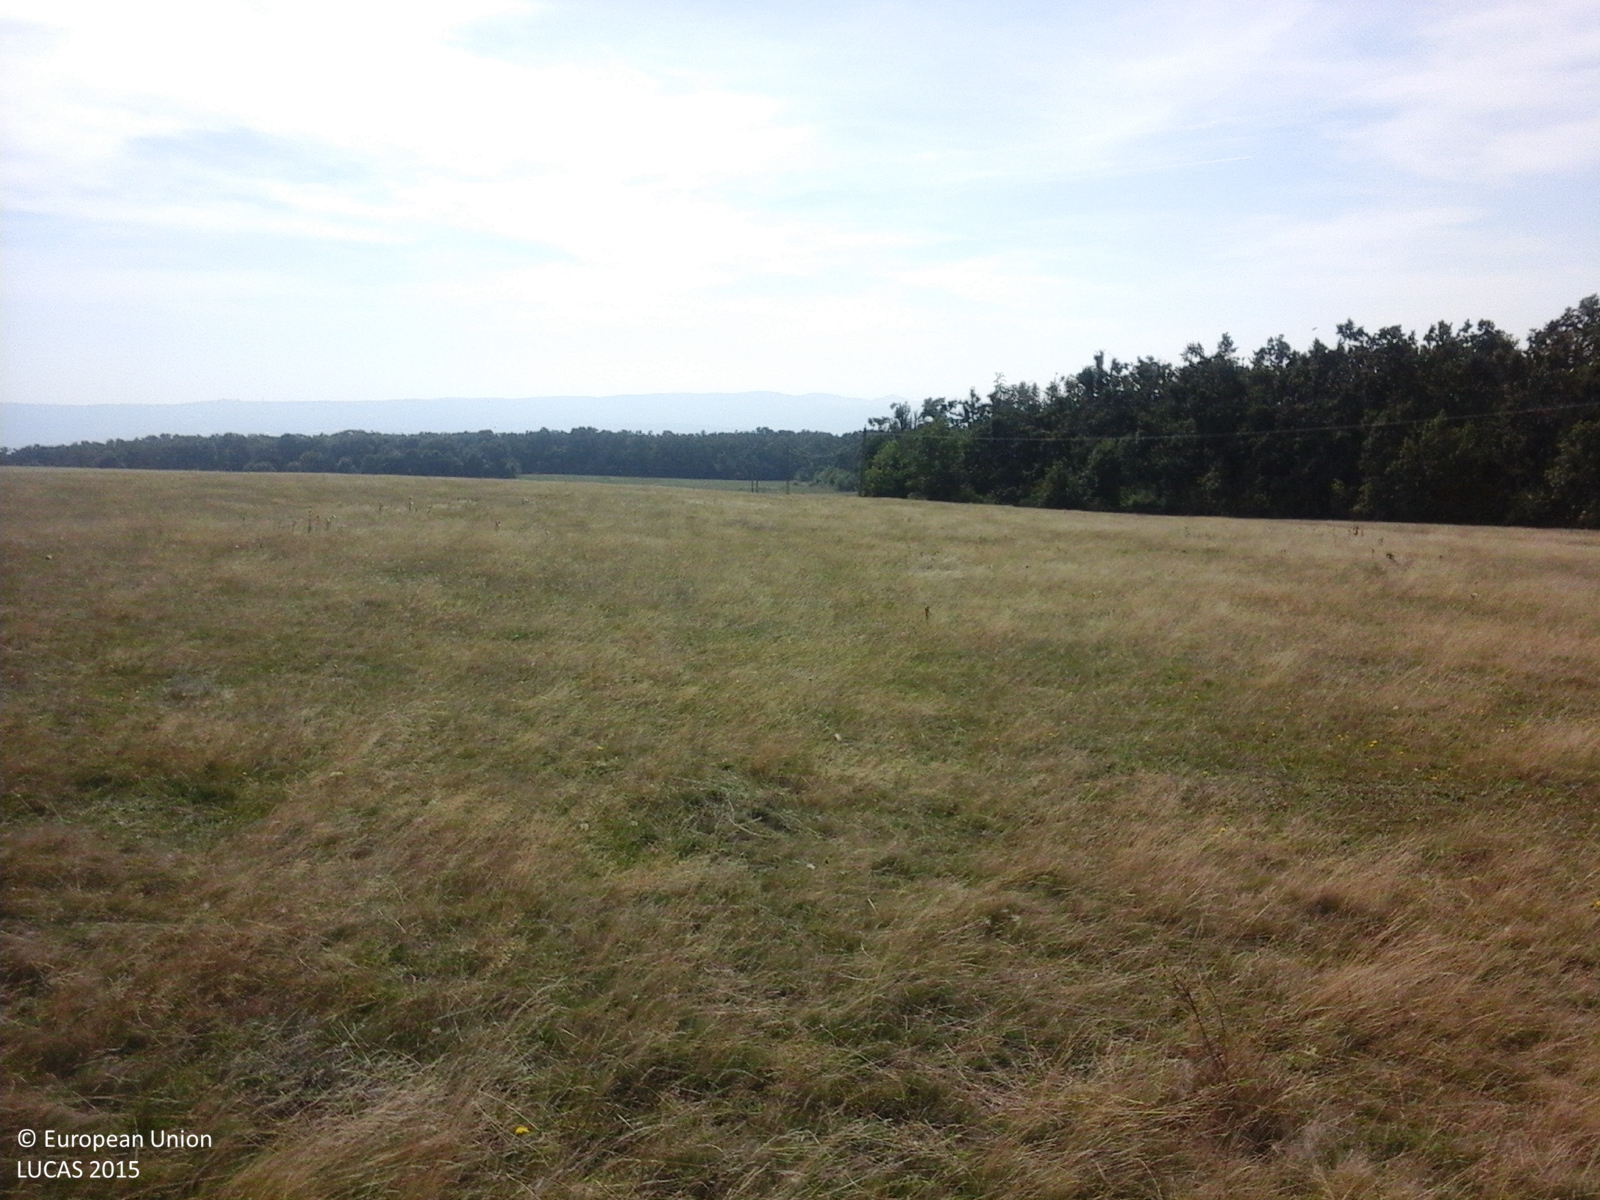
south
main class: Grassland
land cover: Grassland without tree/shrub cover
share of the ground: > 75 %
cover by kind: herbaceous plants 100 %
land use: Agriculture (excluding fallow land and kitchen gardens)
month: September
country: RO
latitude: 46.8156
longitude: 23.5570
